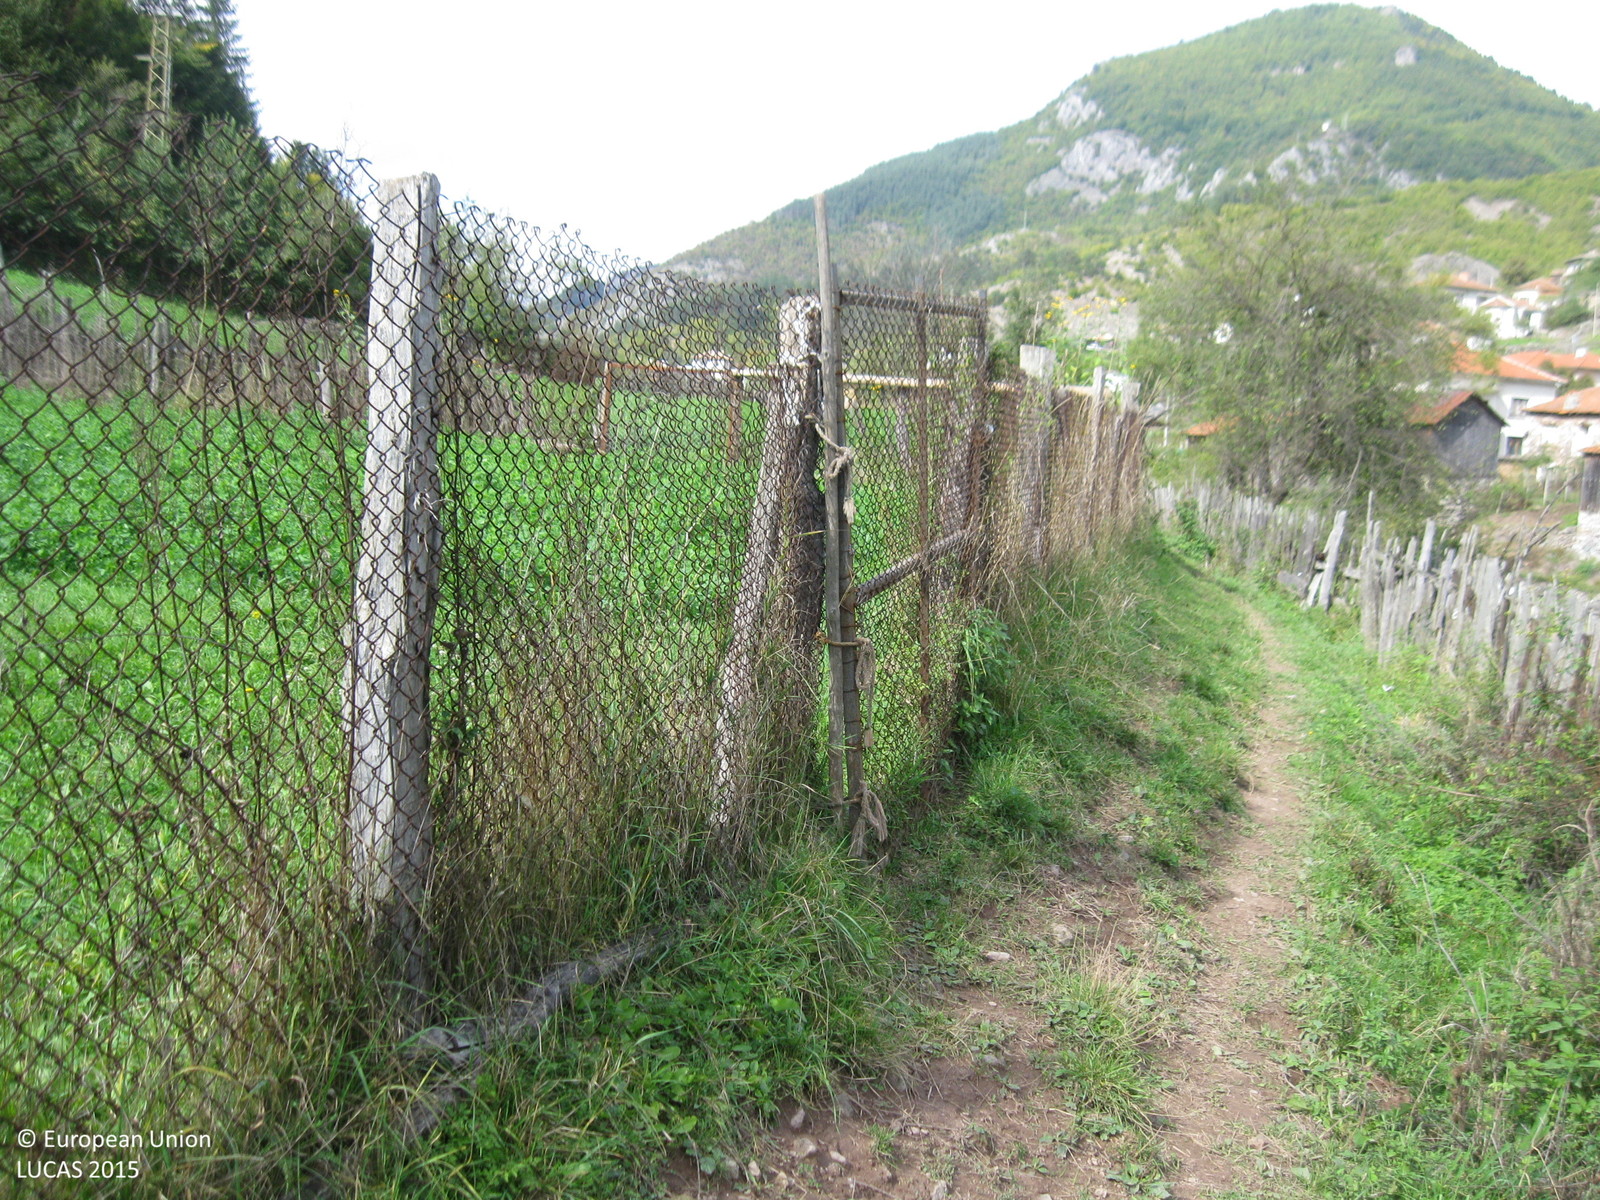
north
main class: Woodland
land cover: Pine dominated mixed woodland
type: mountainous beech forest
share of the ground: > 75 %
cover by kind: coniferous forest trees 50 %, broadleaved forest trees 45 %, shrubs 5 %
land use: Forestry
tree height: > 5 m
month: October
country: BG
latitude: 41.8207
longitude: 24.8943
